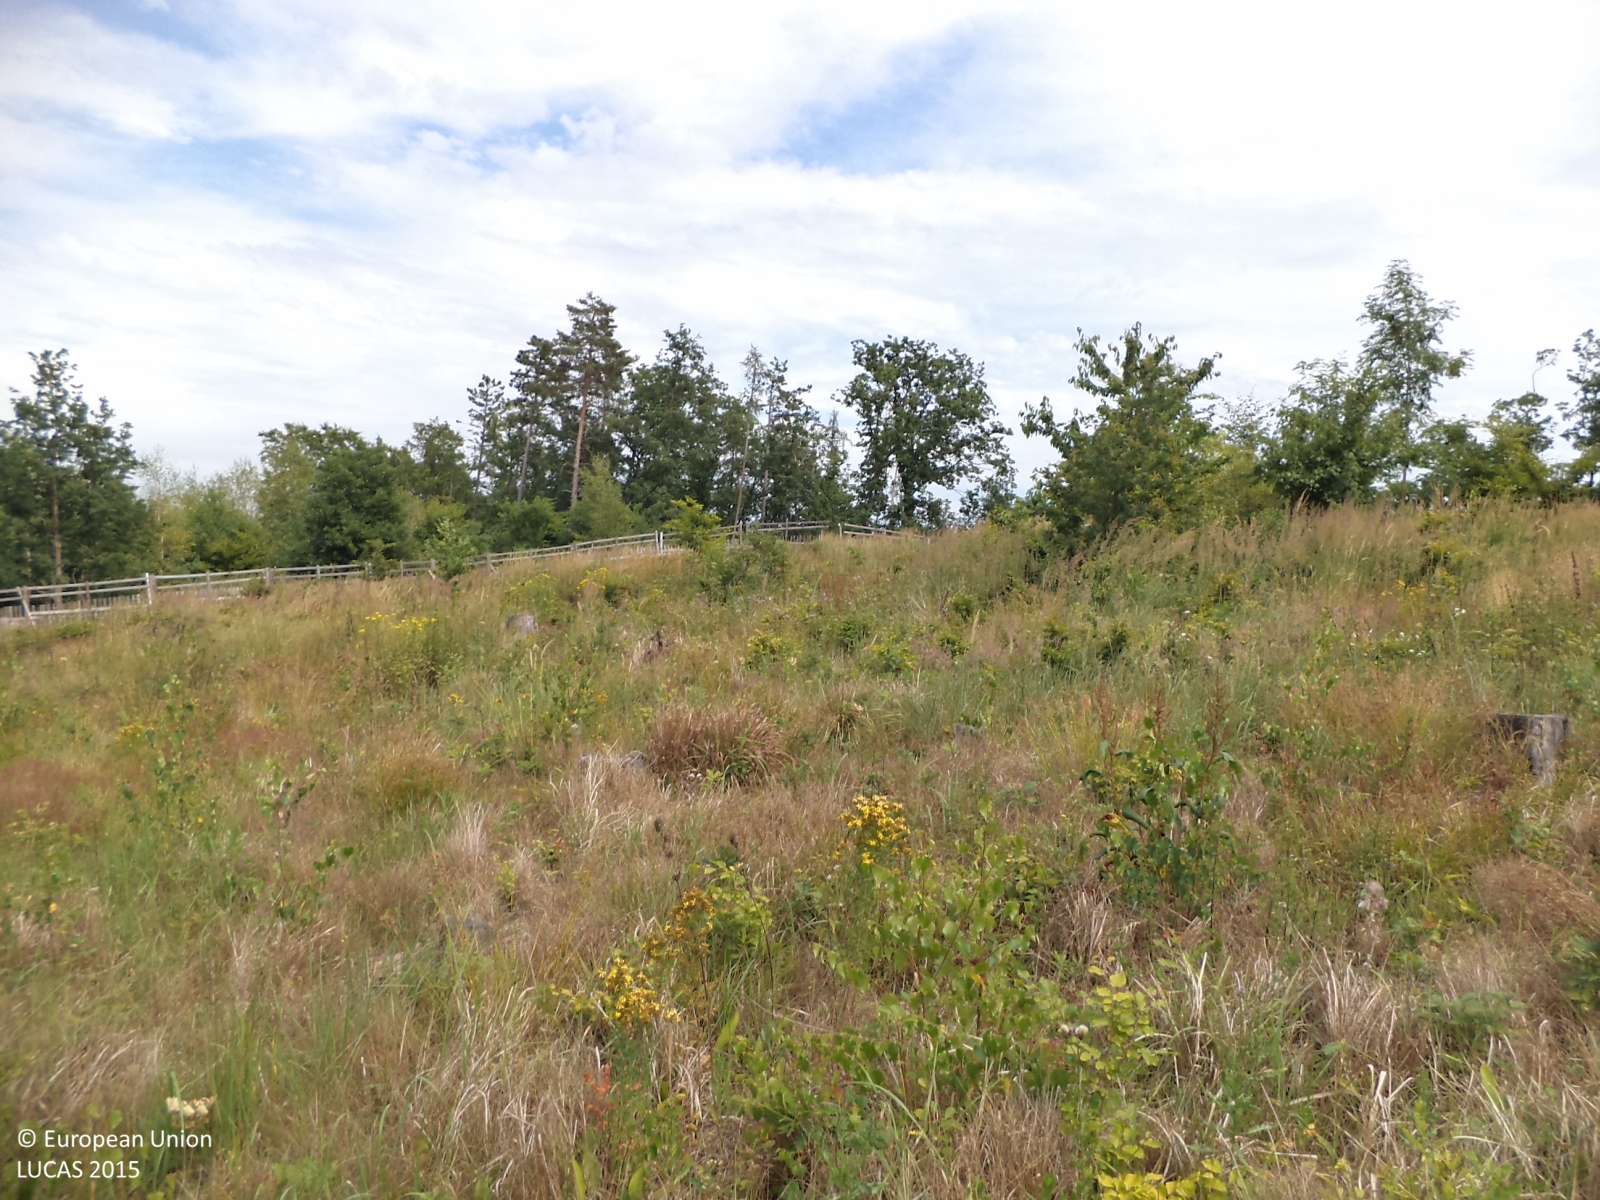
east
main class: Grassland
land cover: Grassland with sparse tree/shrub cover
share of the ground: > 75 %
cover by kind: herbaceous plants 95 %, broadleaved forest trees 5 %
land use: Forestry
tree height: < 5 m
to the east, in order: Grassland with sparse tree/shrub cover; Fences; Broadleaved woodland; Fences; Grassland with sparse tree/shrub cover; Fences; Broadleaved woodland; Grassland with sparse tree/shrub cover; Tracks; Grassland with sparse tree/shrub cover; Broadleaved woodland; Barley
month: July
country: CZ
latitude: 49.9351
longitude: 13.9715
